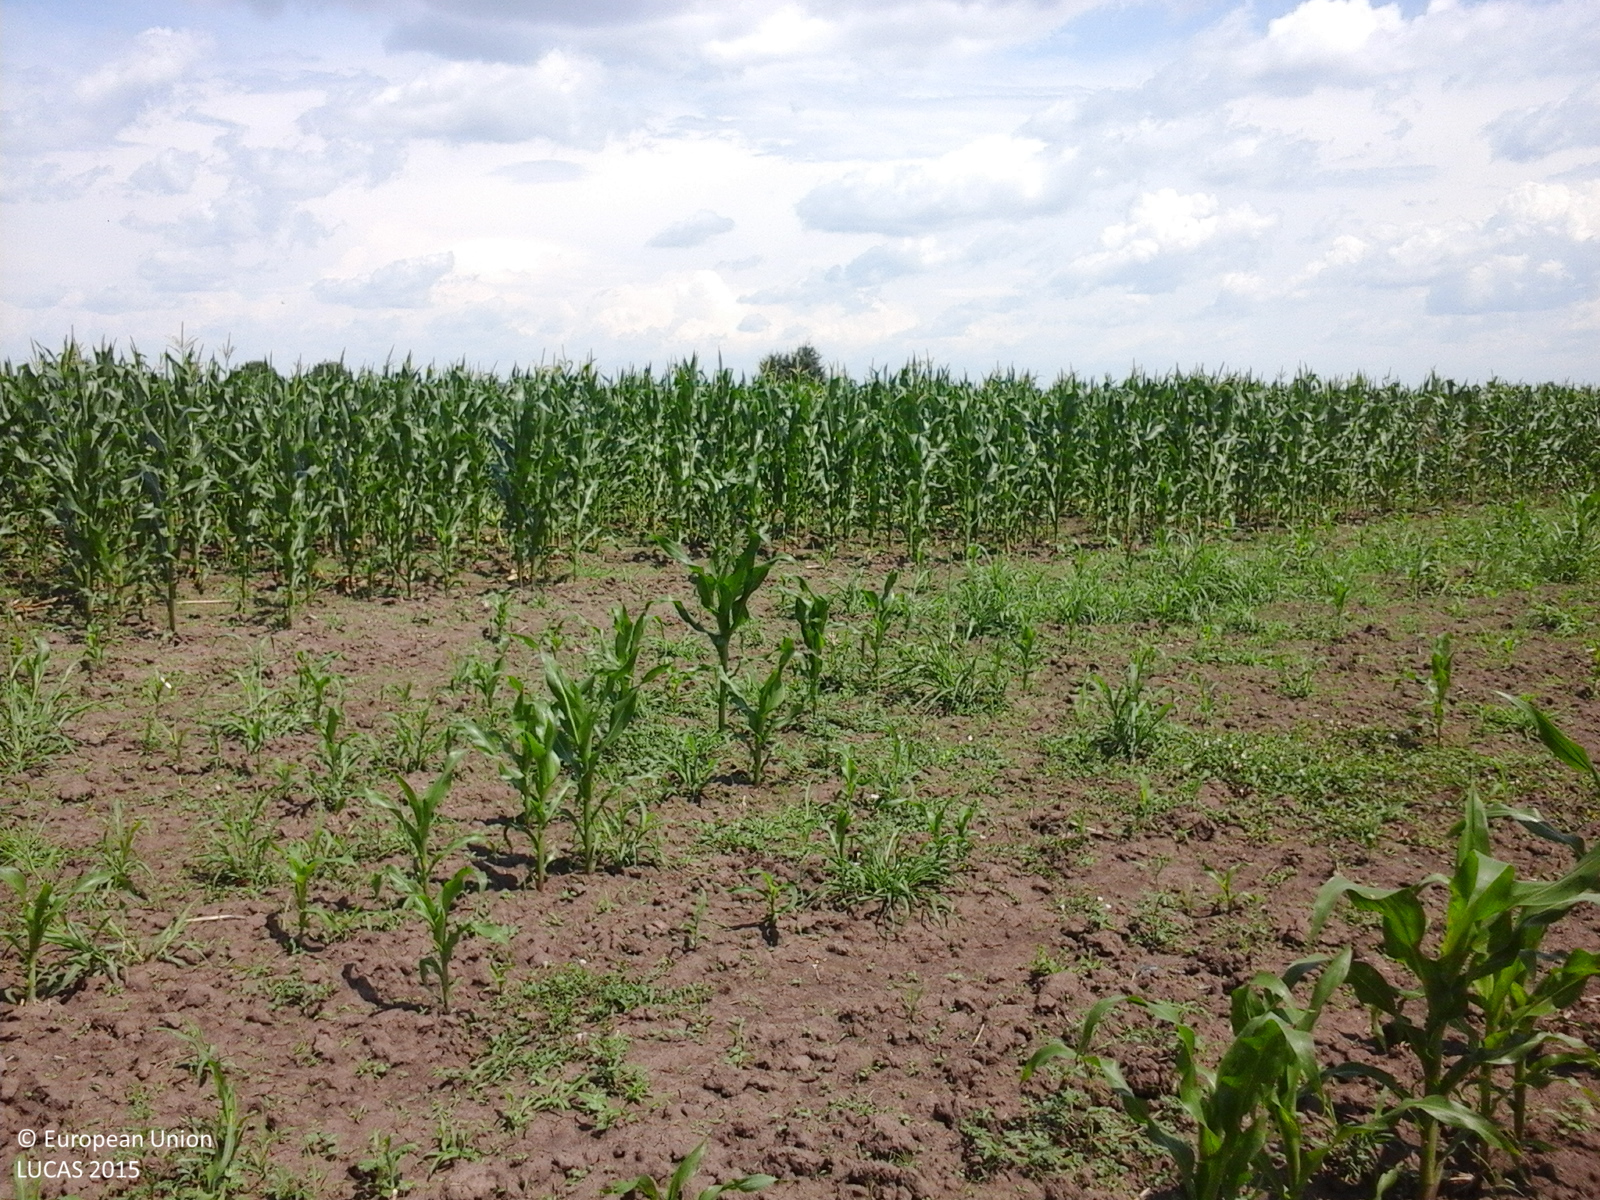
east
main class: Cropland
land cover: Maize
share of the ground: < 10 %
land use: Agriculture (excluding fallow land and kitchen gardens)
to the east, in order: Maize; Lucerne; Maize; Other fresh vegetables; Maize; Single bushes/trees; Lucerne; Maize; Other fresh vegetables; Lucerne; Grass margins; Common wheat
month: July
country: RO
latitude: 44.0741
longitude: 24.5143
